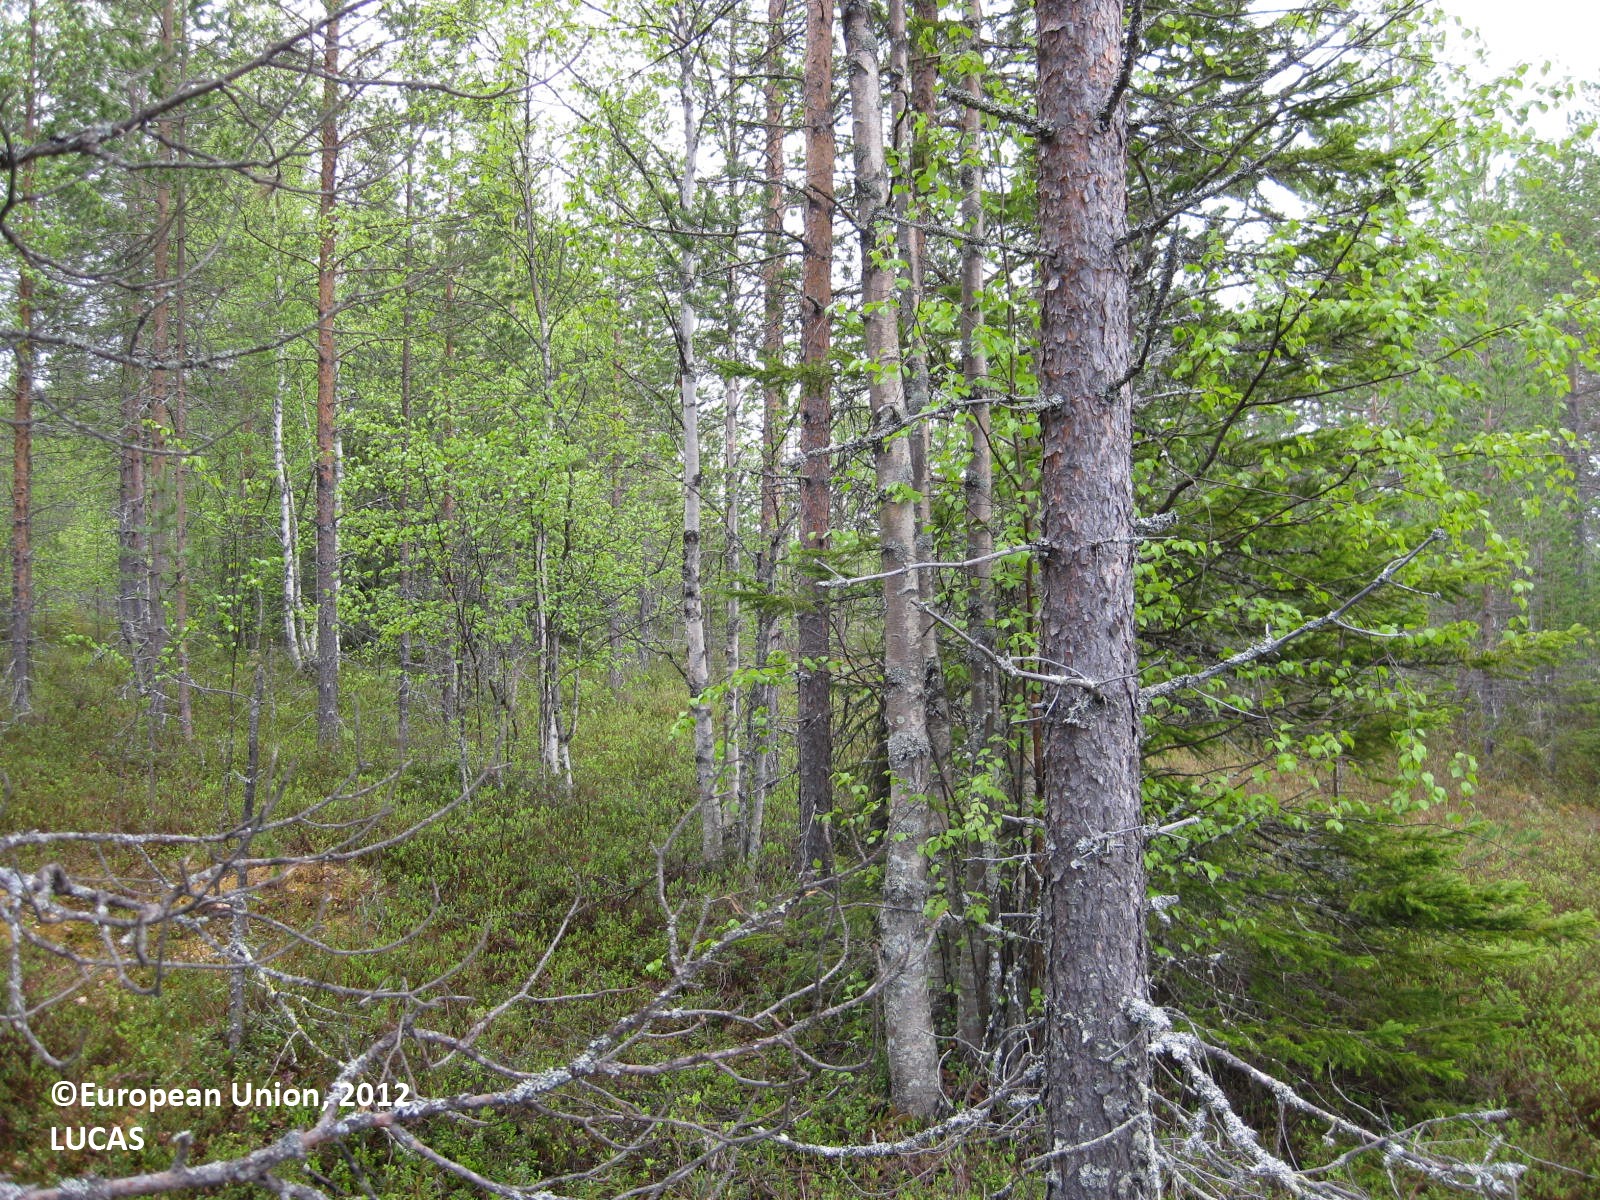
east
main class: Woodland
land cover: Pine dominated mixed woodland
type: boreal forest
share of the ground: 50 - 75 %
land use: Forestry
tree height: > 5 m
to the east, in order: Pine dominated mixed woodland; Pine dominated coniferous woodland; Pine dominated mixed woodland
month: June
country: FI
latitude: 65.1745
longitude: 29.6557
